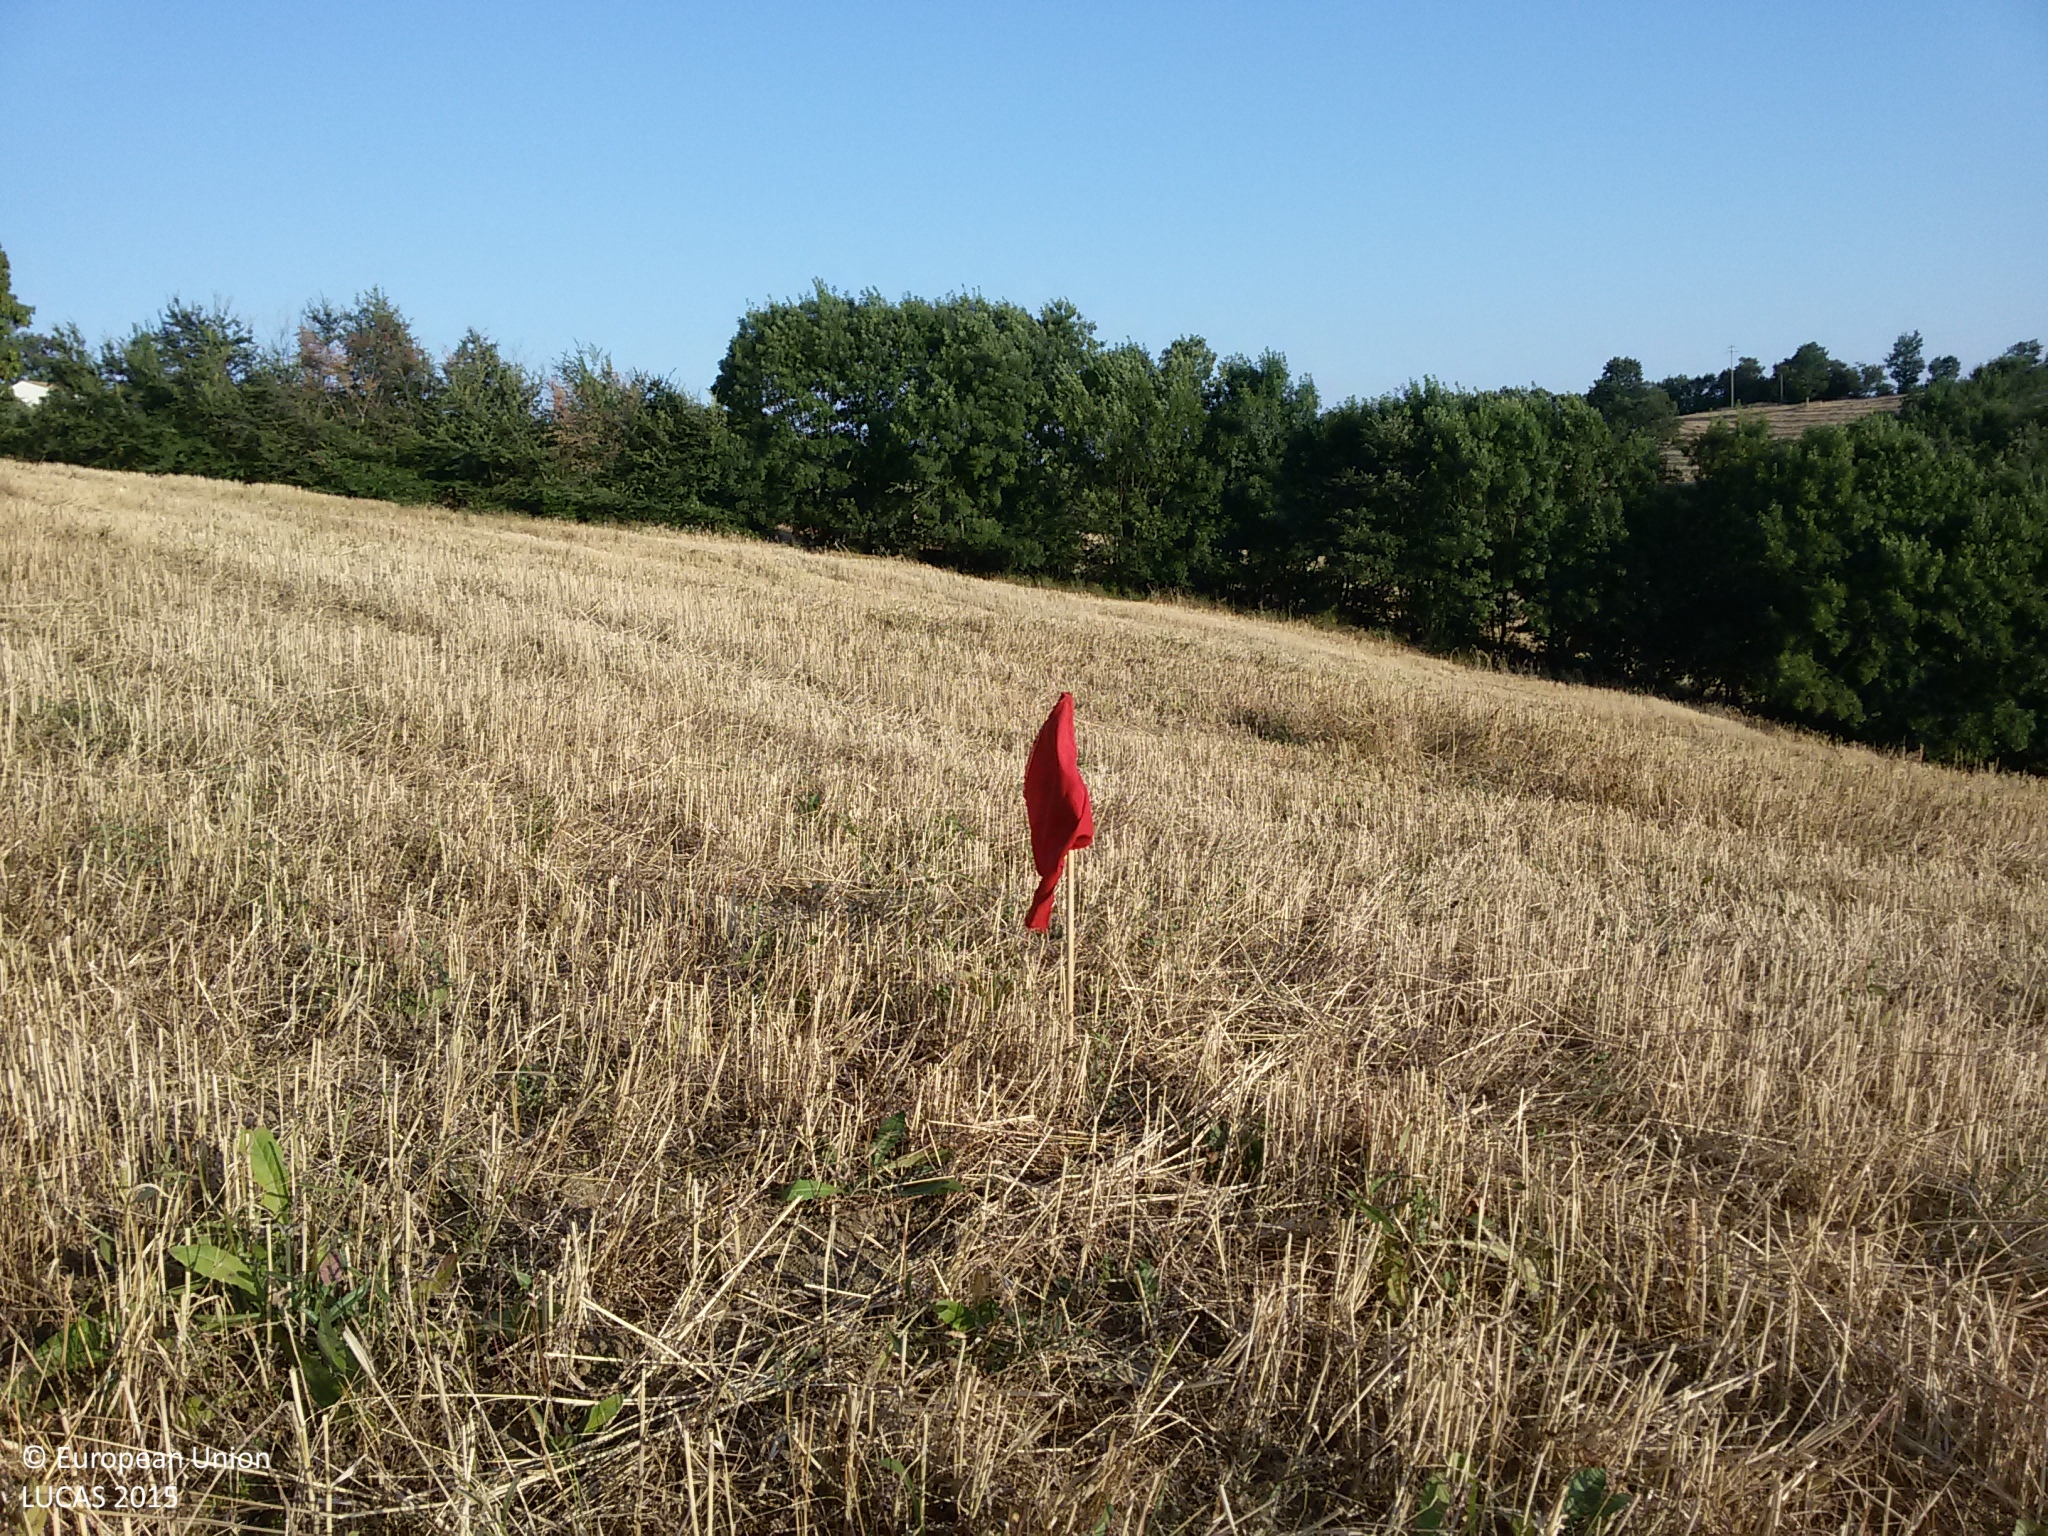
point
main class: Cropland
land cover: Durum wheat
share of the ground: > 75 %
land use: Agriculture (excluding fallow land and kitchen gardens)
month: July
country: IT
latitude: 42.7517
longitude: 11.4735
